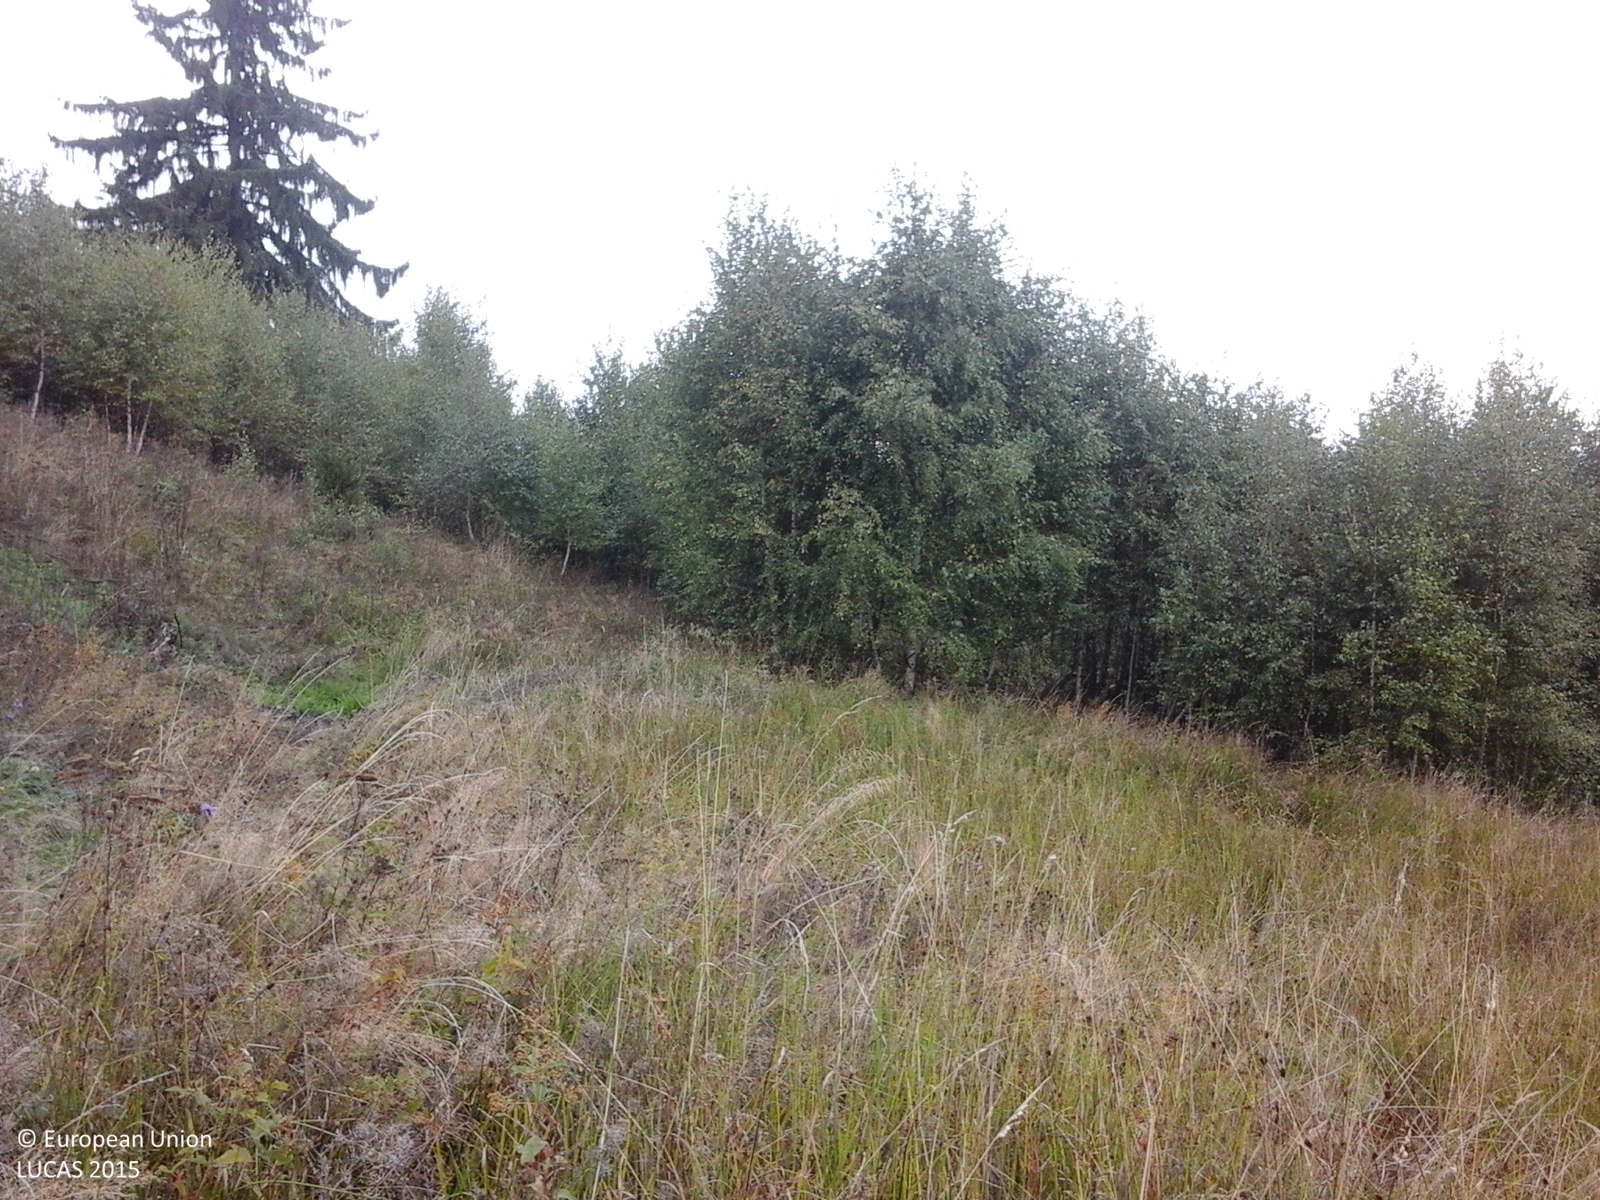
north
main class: Grassland
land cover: Spontaneously vegetated surfaces
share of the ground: > 75 %
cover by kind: herbaceous plants 100 %
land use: Forestry
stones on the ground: < 10 %
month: October
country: RO
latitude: 45.7360
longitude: 23.8586
